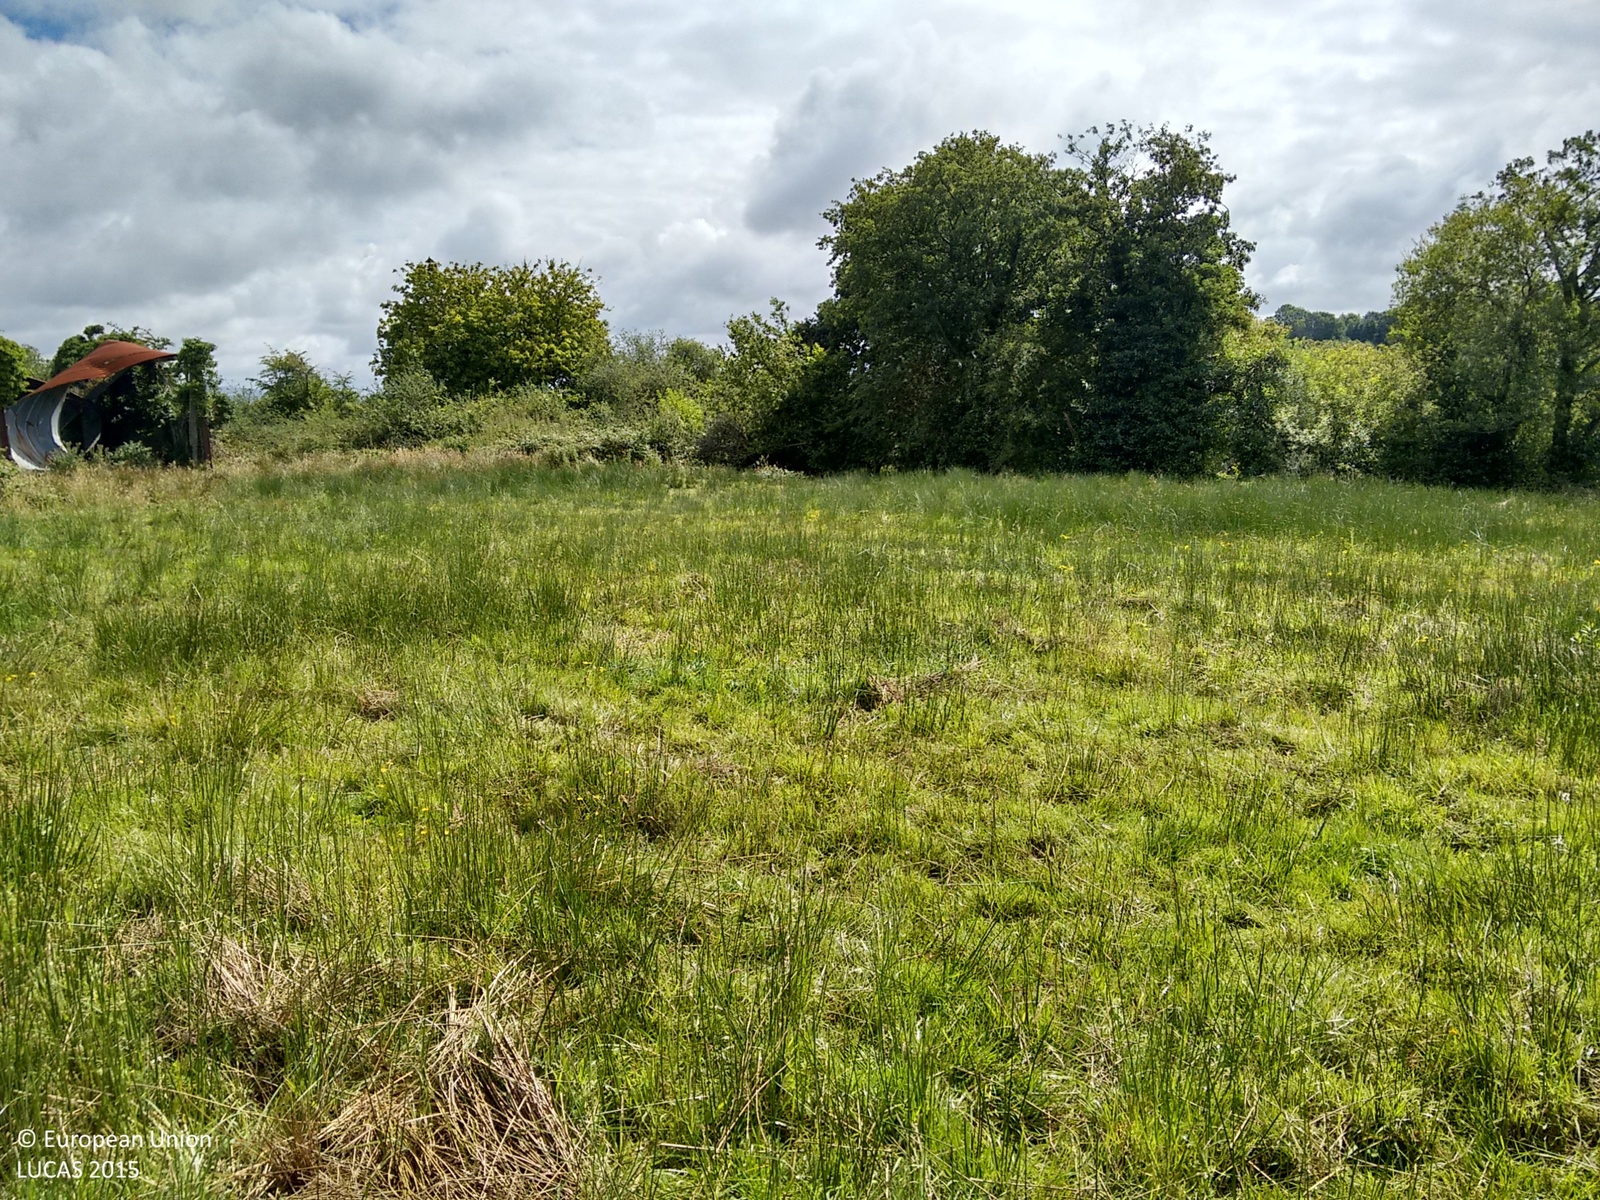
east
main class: Grassland
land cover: Grassland without tree/shrub cover
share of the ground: > 75 %
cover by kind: herbaceous plants 100 %
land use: Agriculture (excluding fallow land and kitchen gardens)
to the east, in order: Grassland without tree/shrub cover; Shrubland with sparse tree cover; Fences; Shrubland with sparse tree cover; Grassland without tree/shrub cover; Abandoned hedges; Fences; Abandoned hedges; Artificial constructions in urban areas; Managed hedges; Fences; Managed hedges; Grassland without tree/shrub cover
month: July
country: GB
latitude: 51.8086
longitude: -4.0632
